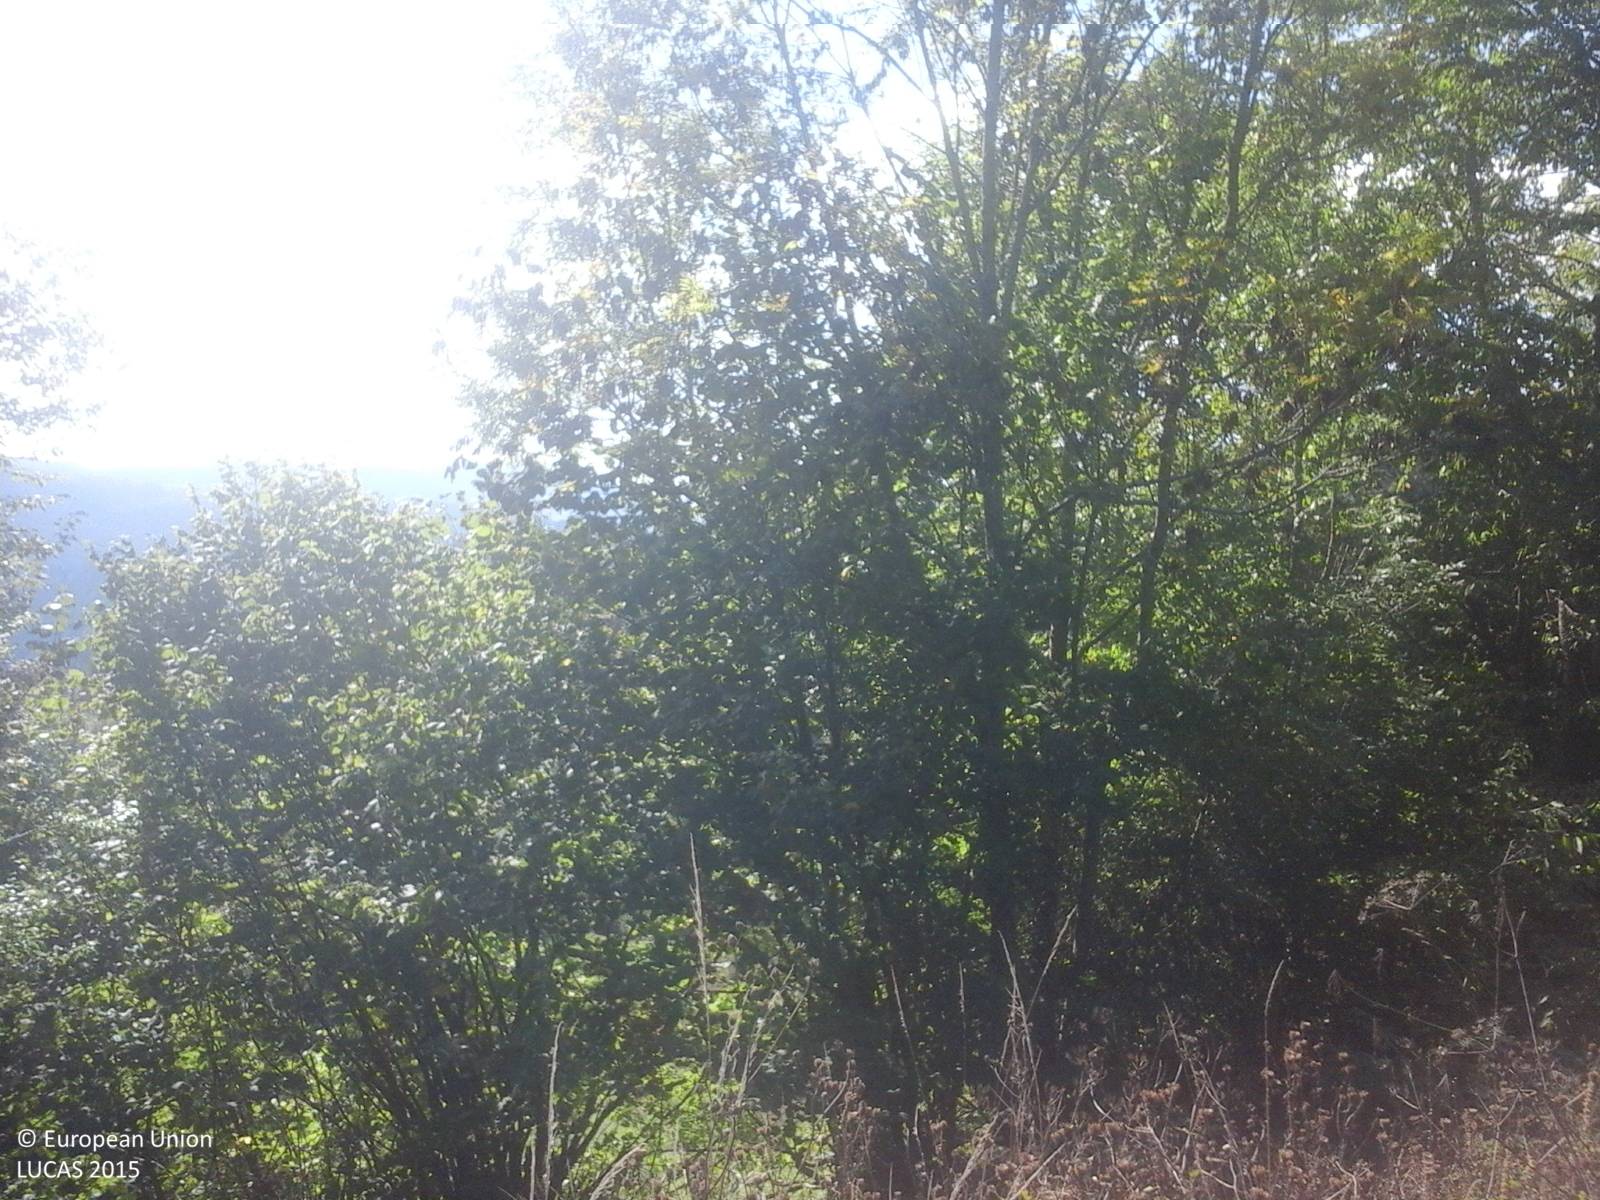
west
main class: Grassland
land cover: Grassland with sparse tree/shrub cover
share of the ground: > 75 %
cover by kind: herbaceous plants 85 %, shrubs 10 %, broadleaved forest trees 5 %
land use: Semi-natural and natural areas not in use
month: October
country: RO
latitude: 46.4105
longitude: 23.0026
